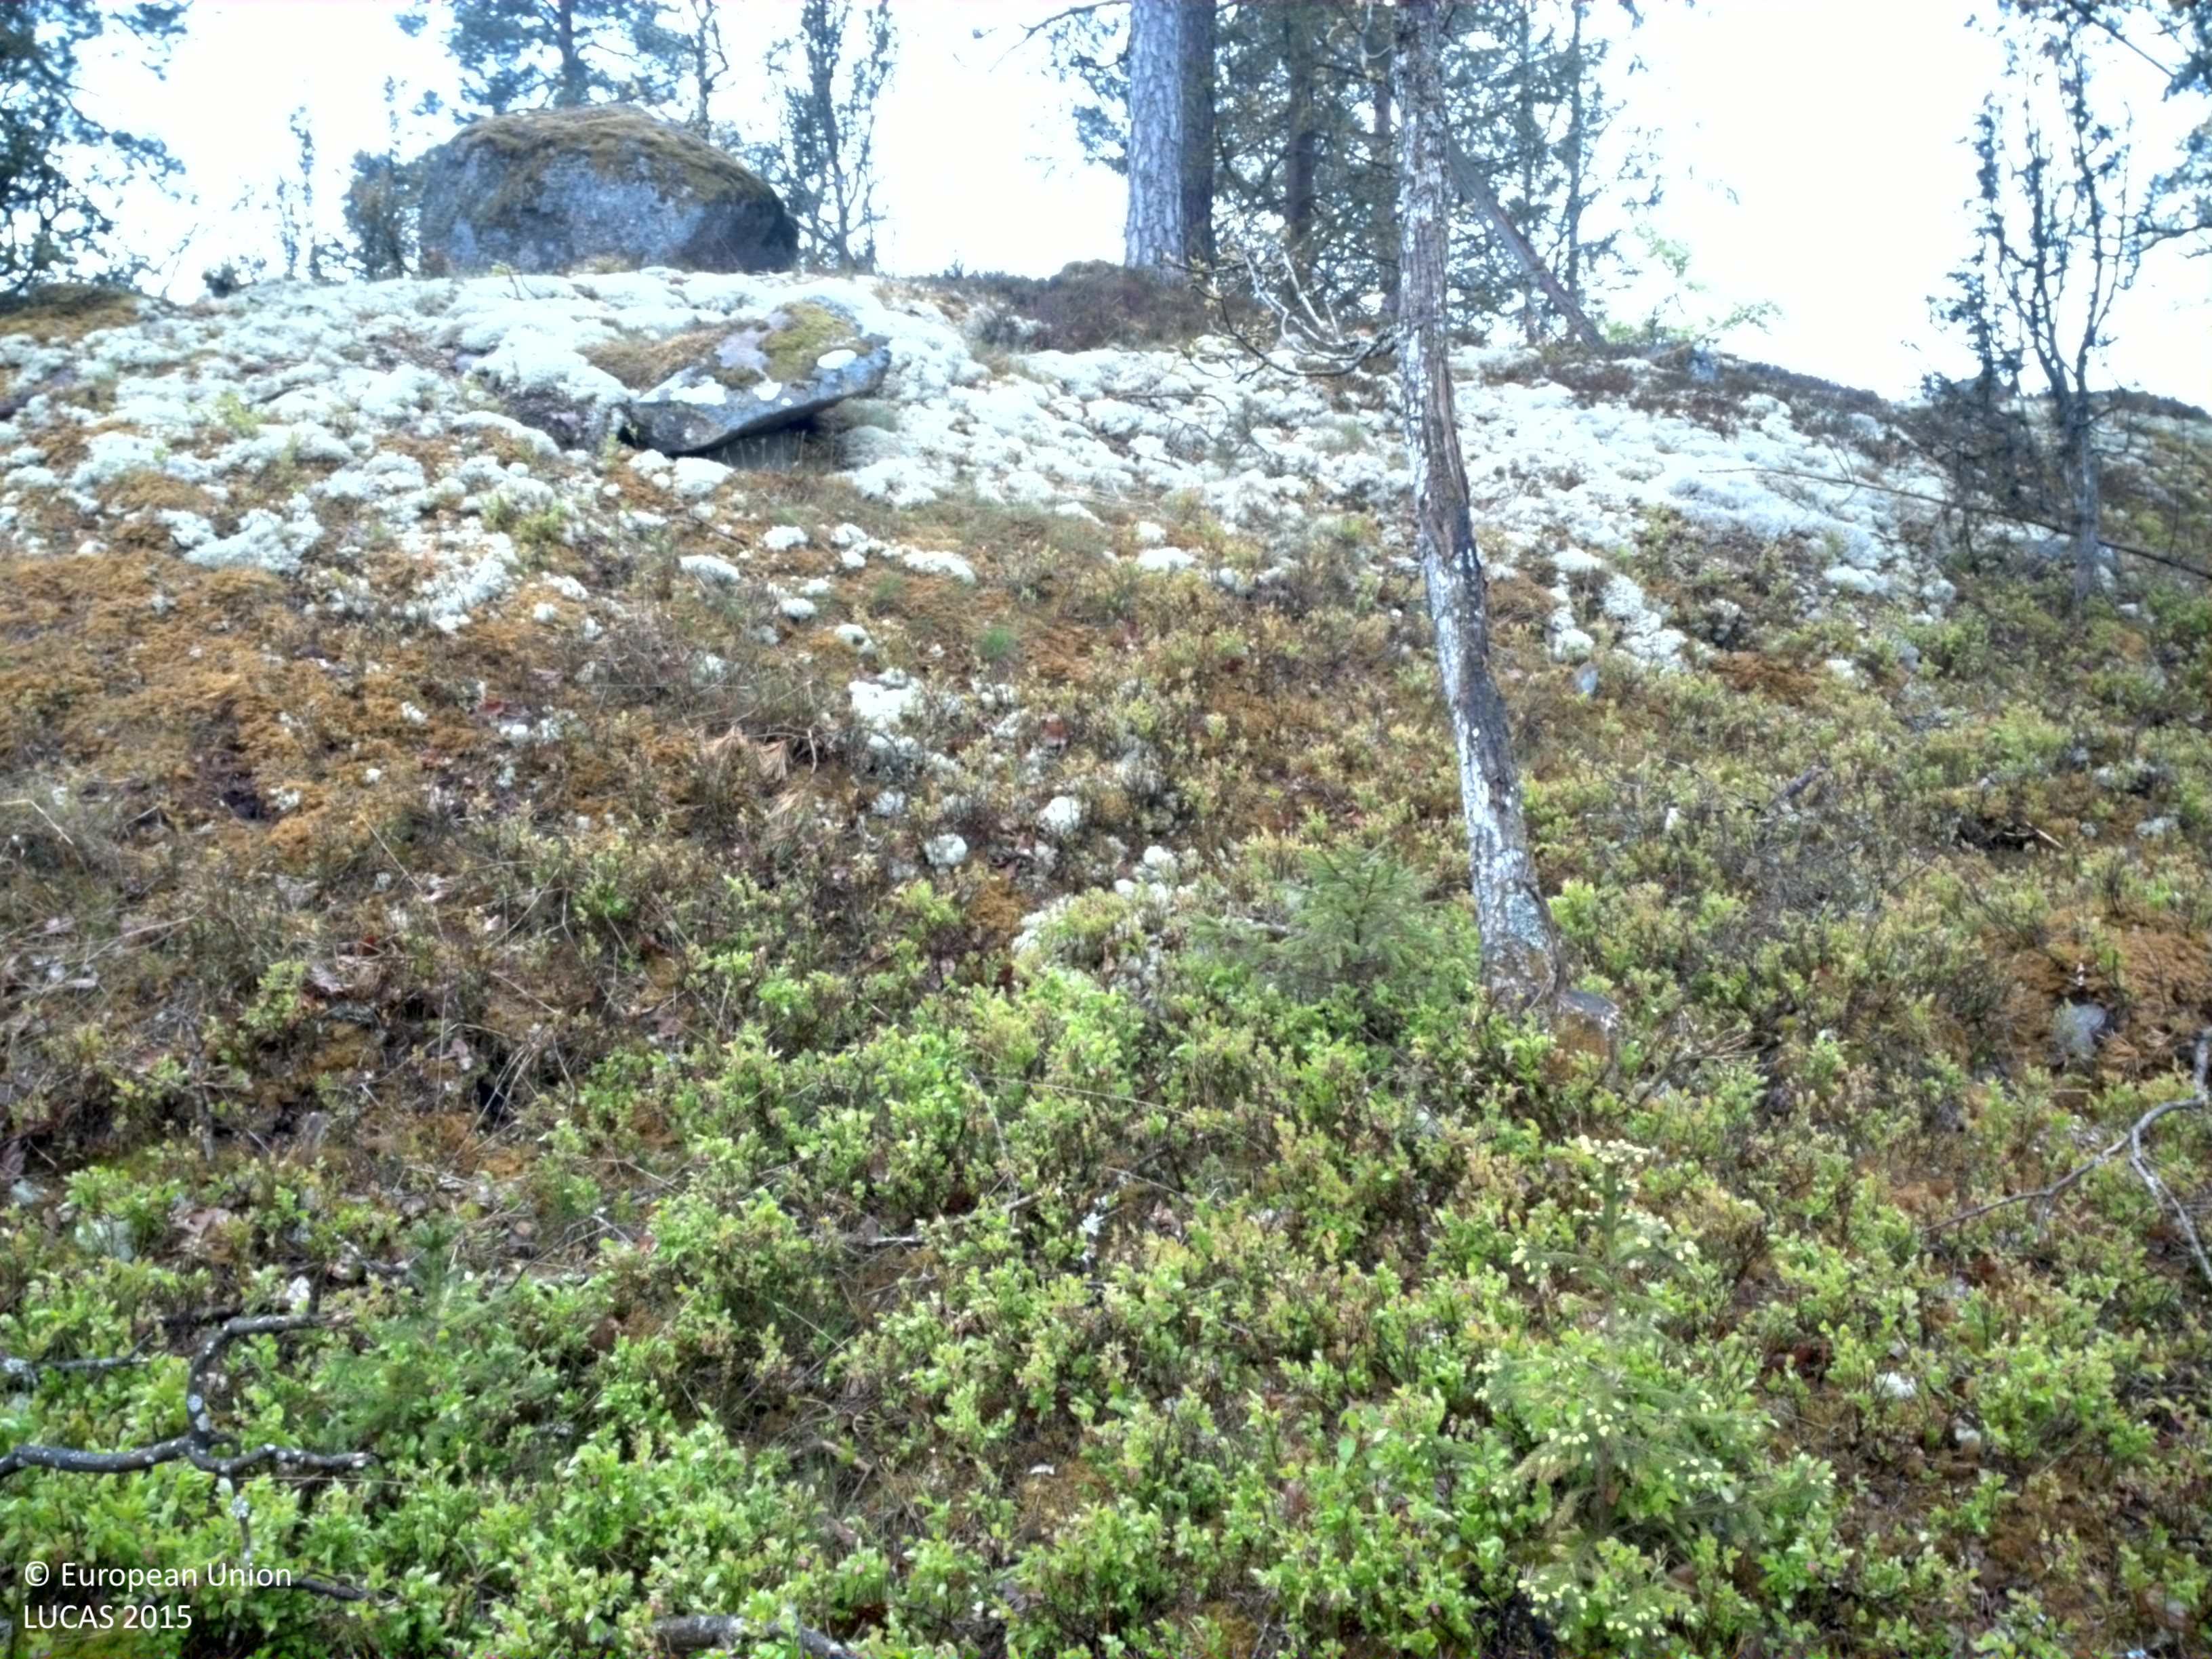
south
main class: Shrubland
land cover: Shrubland with sparse tree cover
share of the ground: 50 - 75 %
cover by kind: shrubs 65 %, herbaceous plants 25 %, coniferous forest trees 5 %, lichens and mosses 5 %
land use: Forestry
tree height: < 5 m
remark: Clear cut
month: May
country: SE
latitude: 56.3616
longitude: 15.4216
